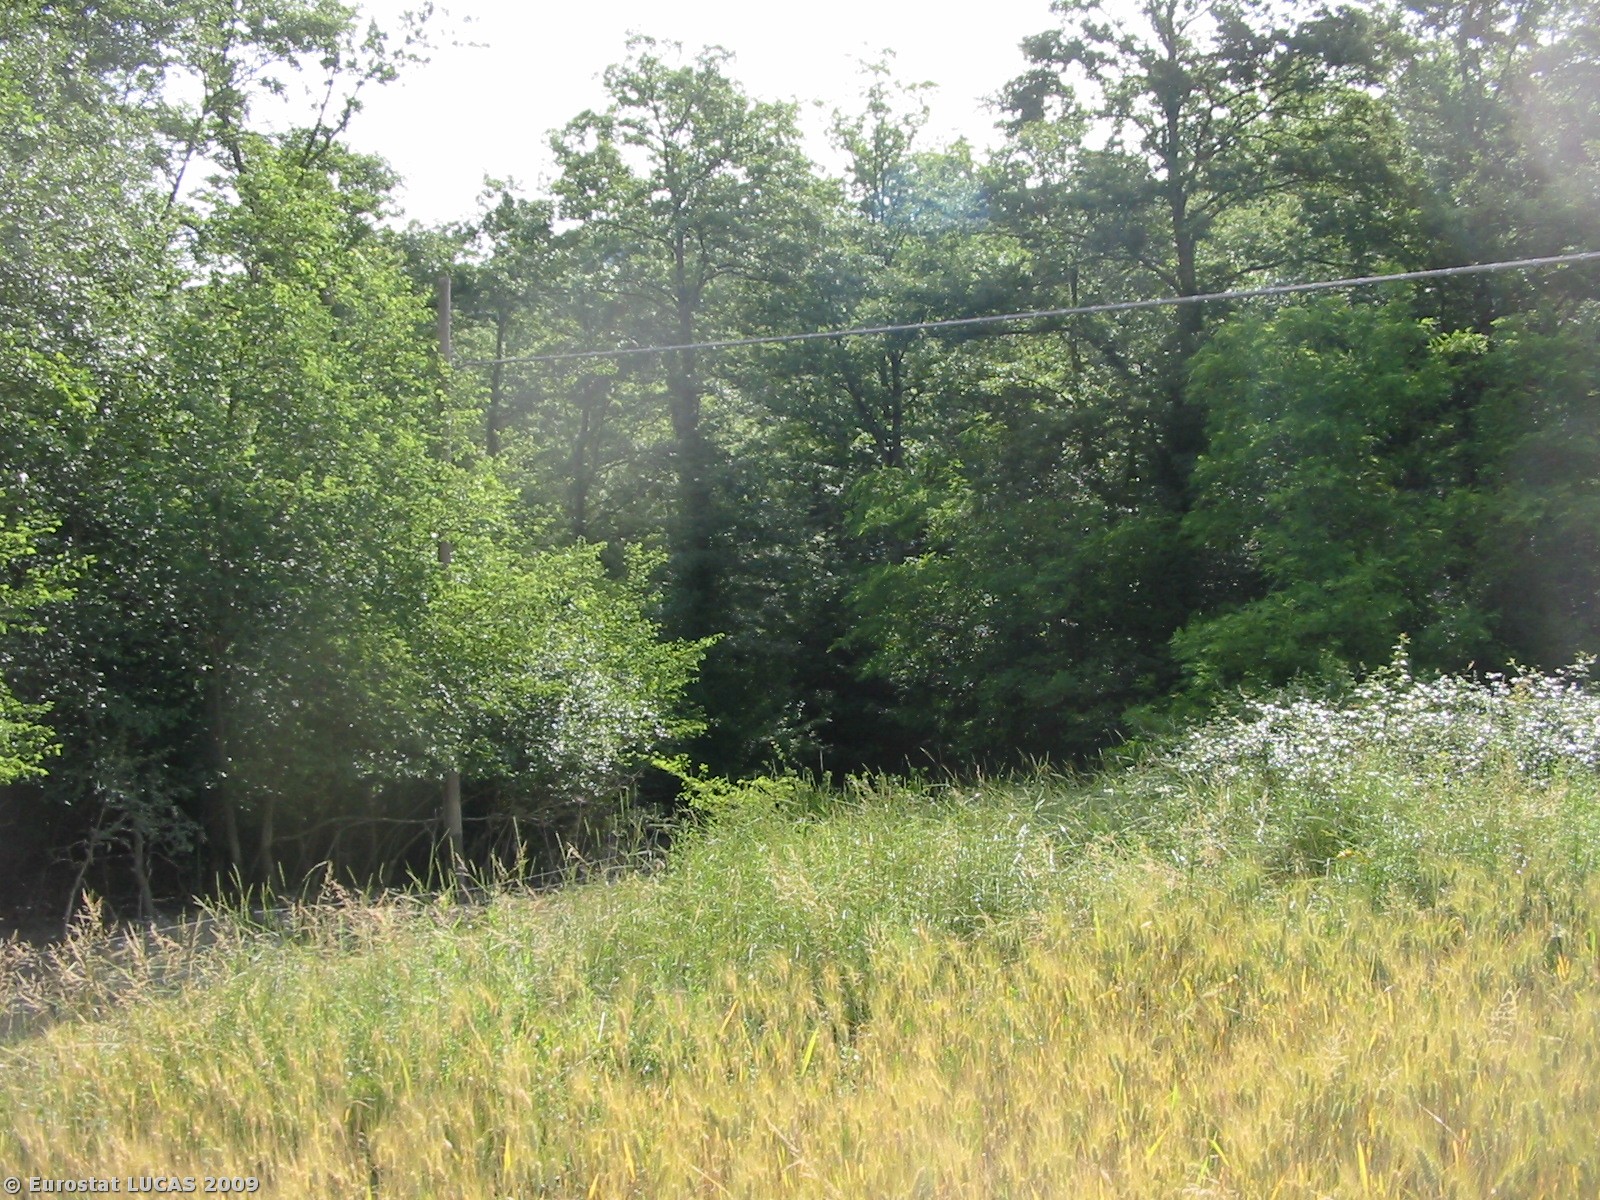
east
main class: Cropland
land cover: Durum wheat
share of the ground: > 75 %
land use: Agriculture (excluding fallow land and kitchen gardens)
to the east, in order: Durum wheat; Abandoned hedges; Electric lines; Inland running water; Broadleaved woodland; Tracks; Broadleaved woodland
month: June
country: IT
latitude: 42.9443
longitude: 11.8449
